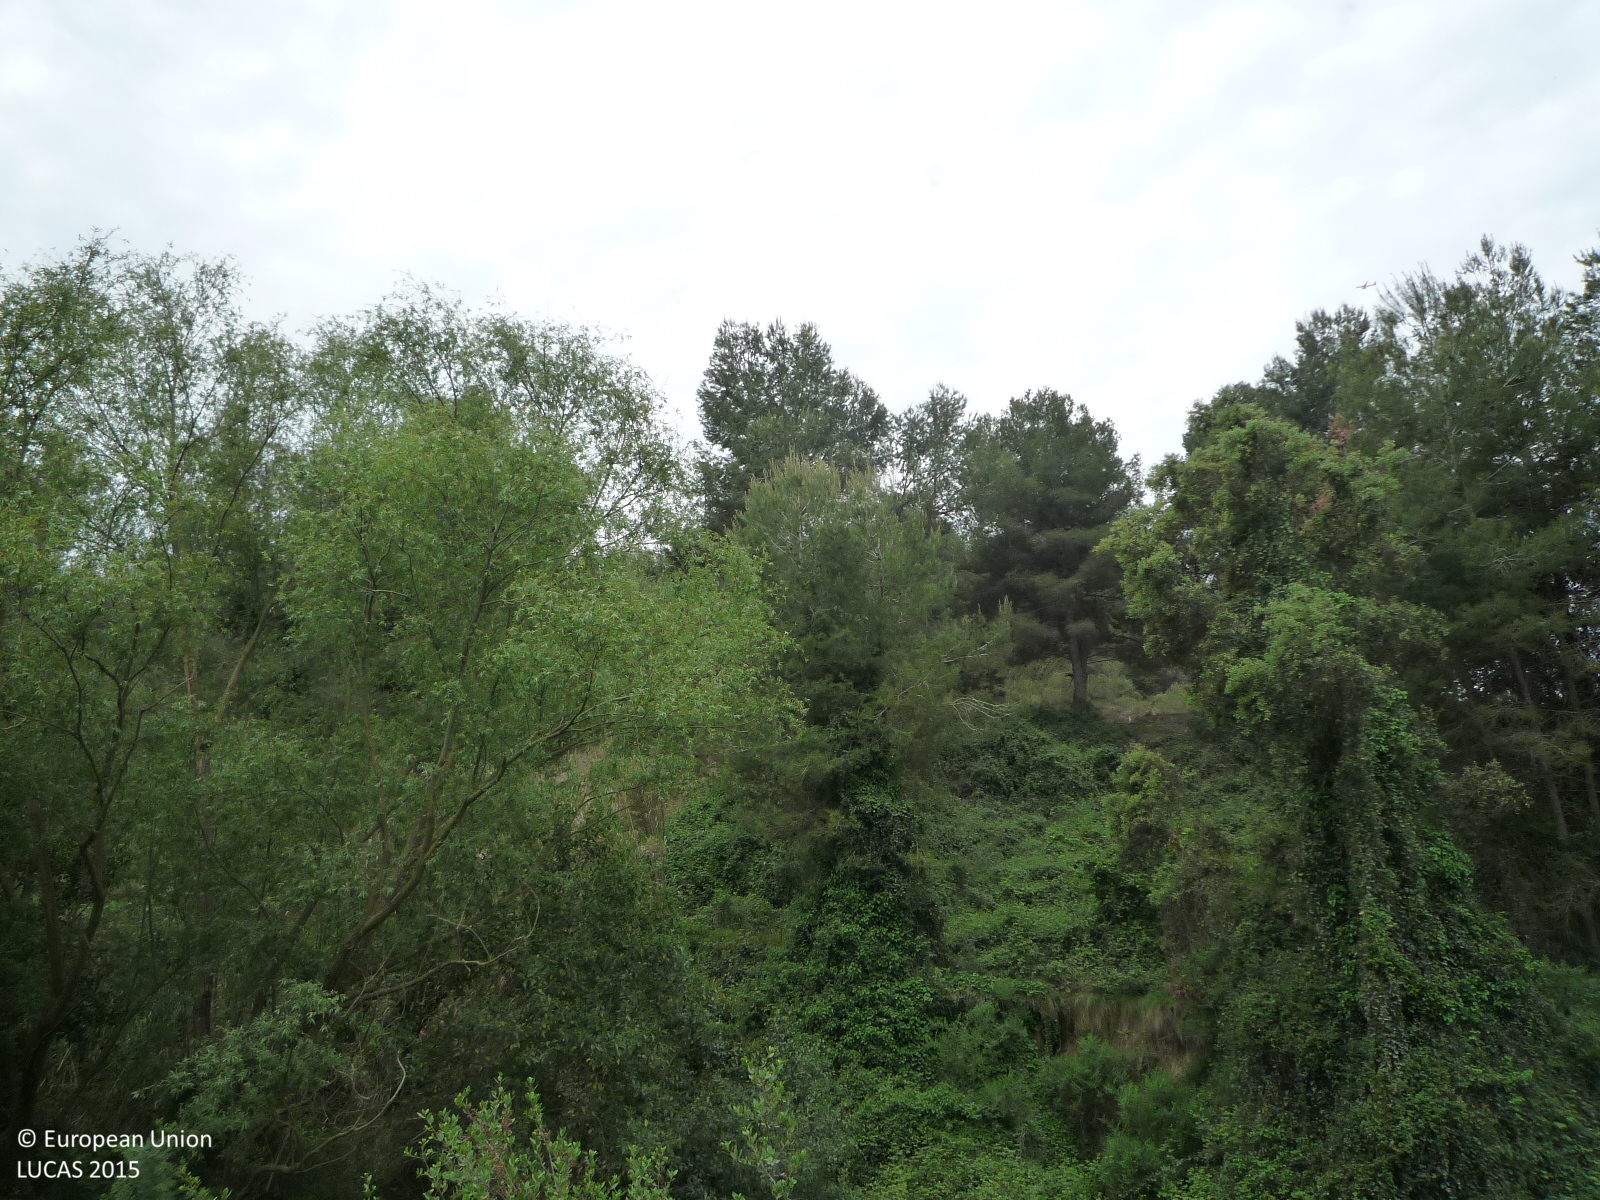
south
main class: Woodland
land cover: Pine dominated mixed woodland
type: coniferous forest of the mediterranean region
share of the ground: > 75 %
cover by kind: coniferous forest trees 60 %, broadleaved forest trees 35 %, shrubs 5 %
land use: Semi-natural and natural areas not in use
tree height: > 5 m
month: May
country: ES
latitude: 41.3117
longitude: 1.6680
